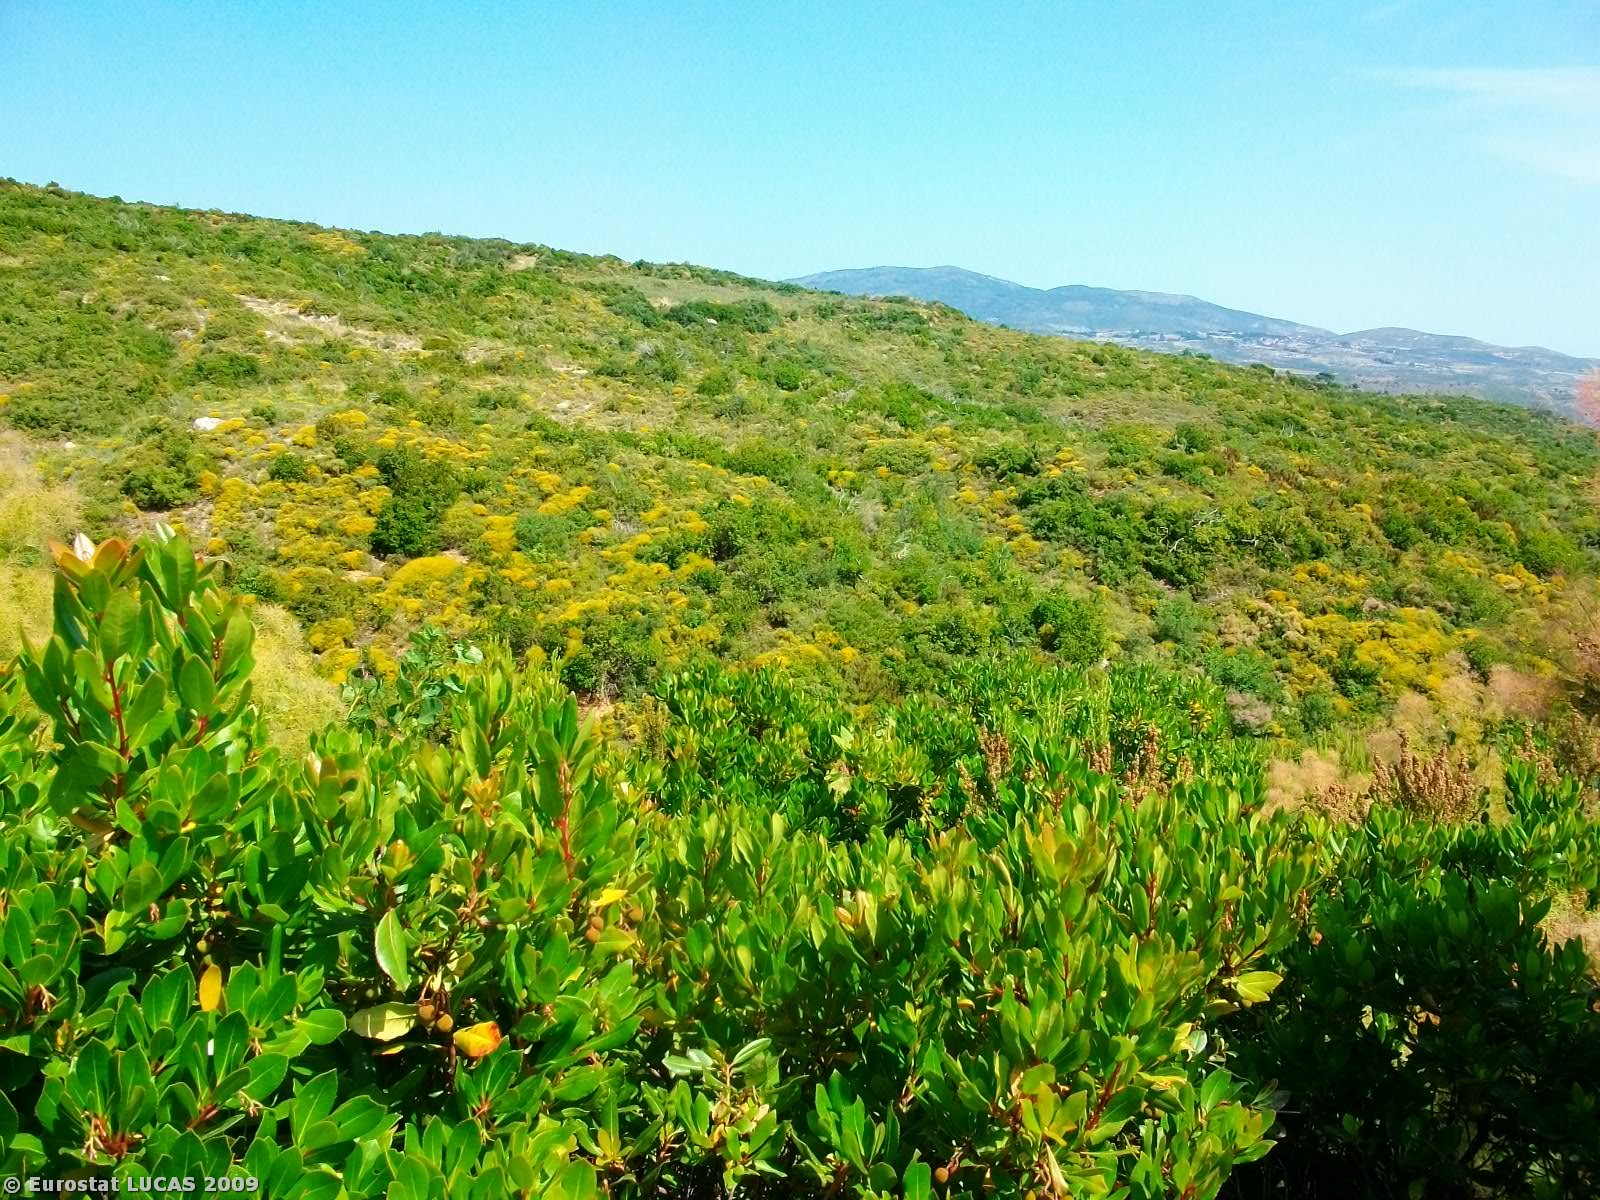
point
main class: Shrubland
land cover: Shrubland without tree cover
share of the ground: > 75 %
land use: Unused
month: June
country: GR
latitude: 39.2350
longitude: 23.2580
